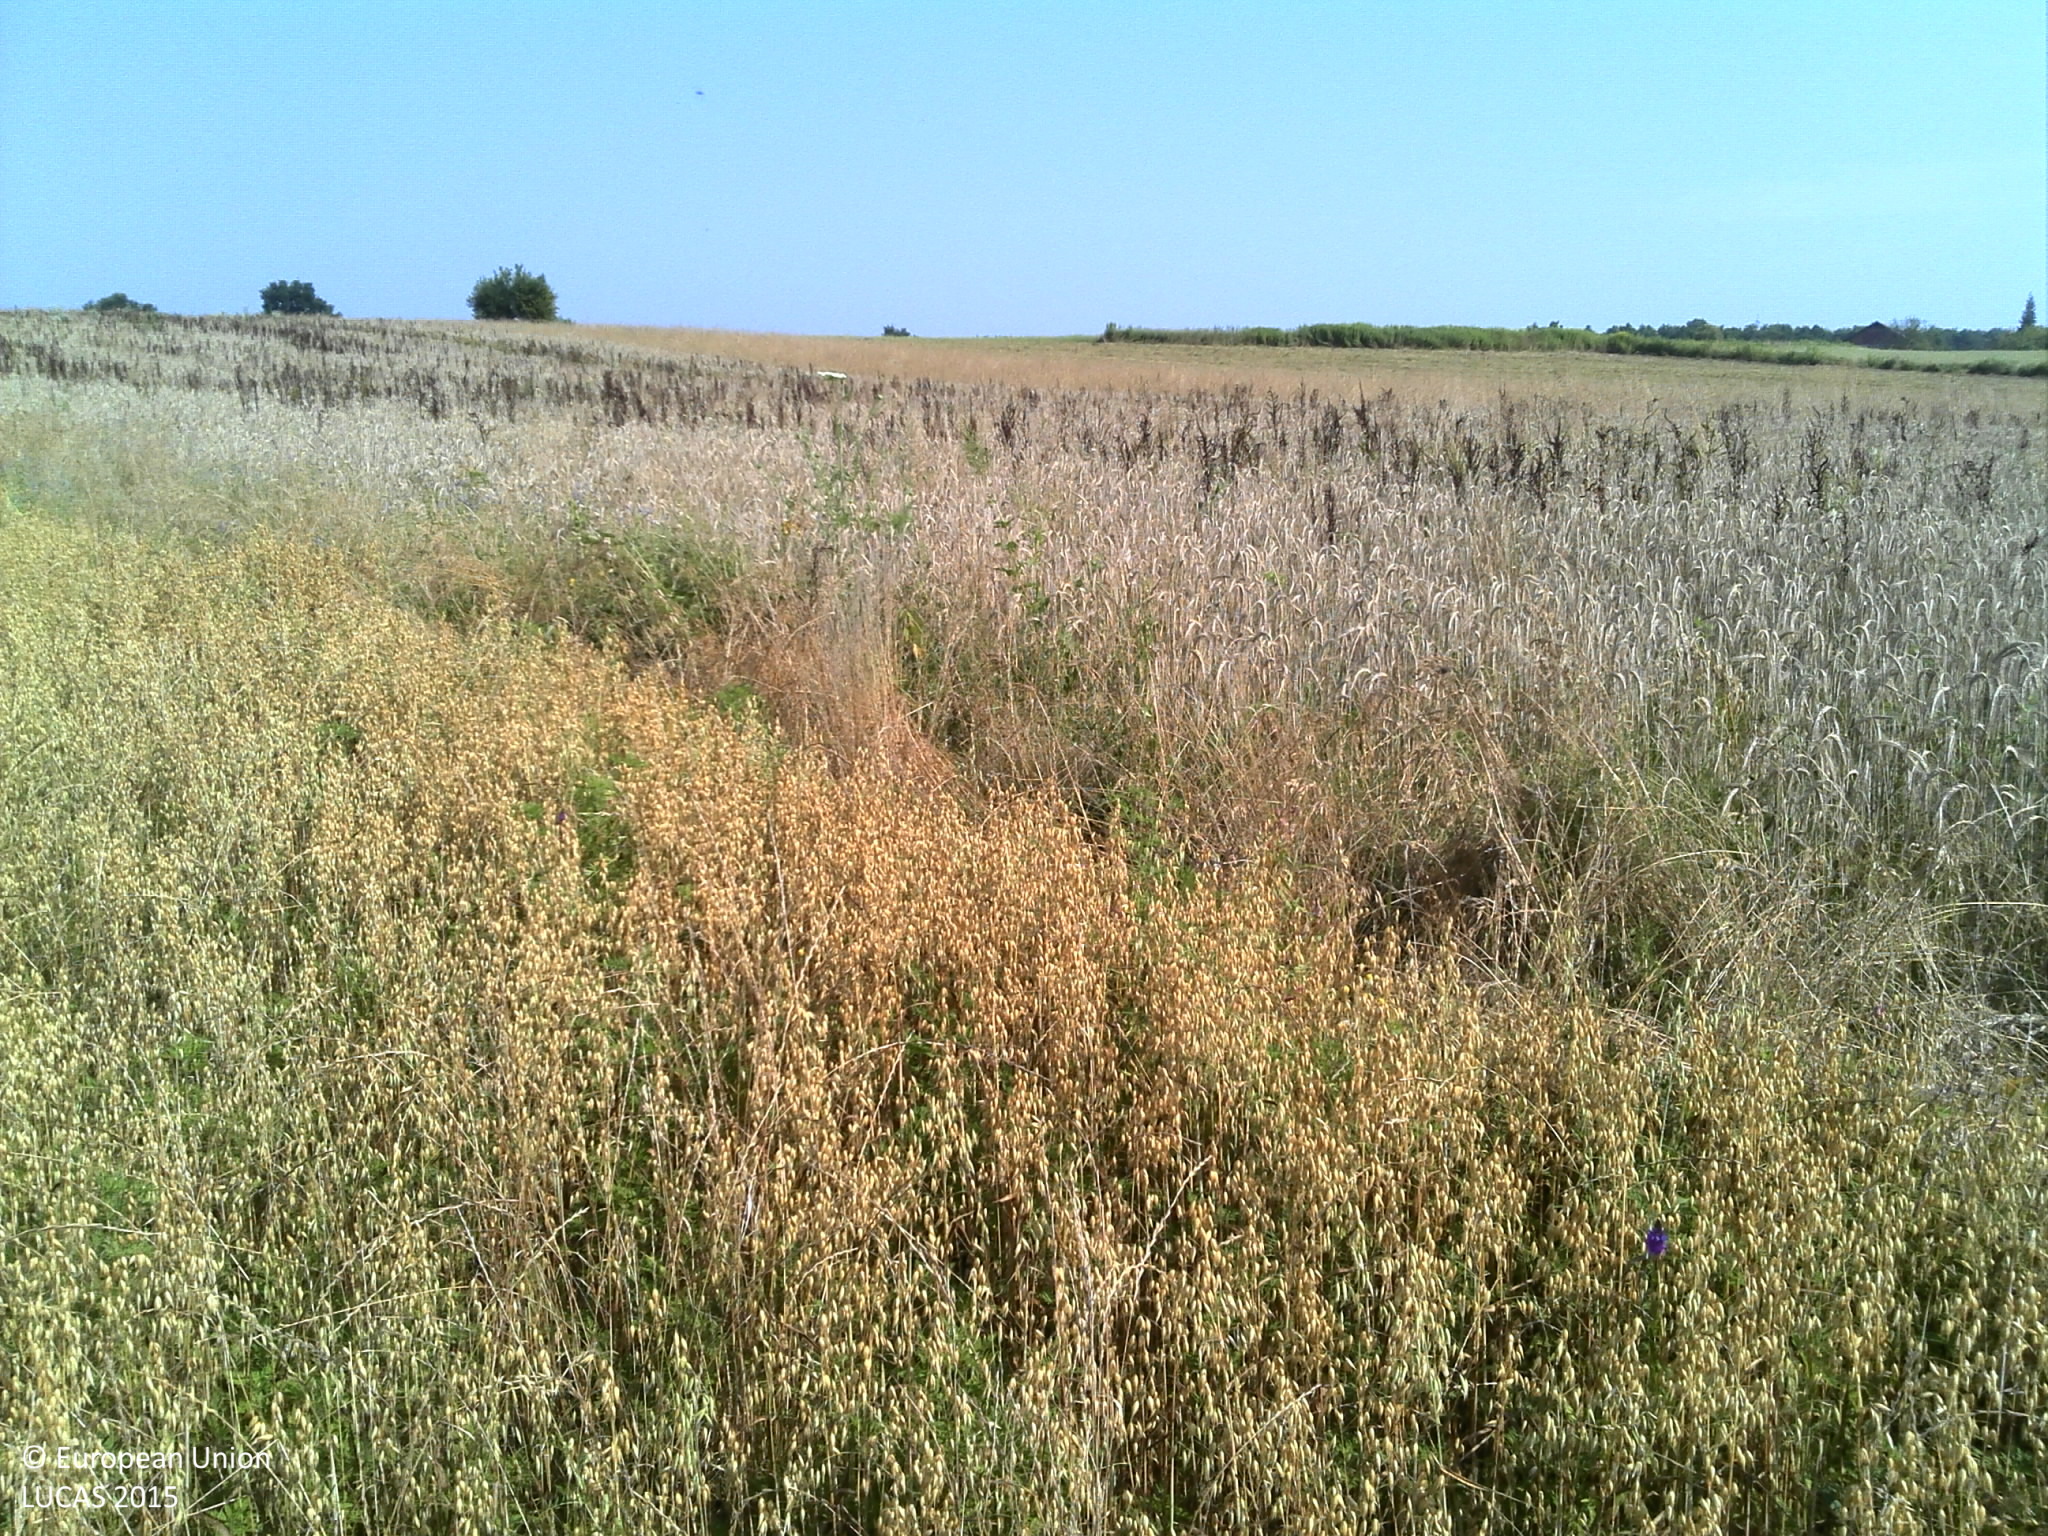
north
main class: Cropland
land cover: Oats
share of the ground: > 75 %
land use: Agriculture (excluding fallow land and kitchen gardens)
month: July
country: HR
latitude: 45.7712
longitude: 16.5447
